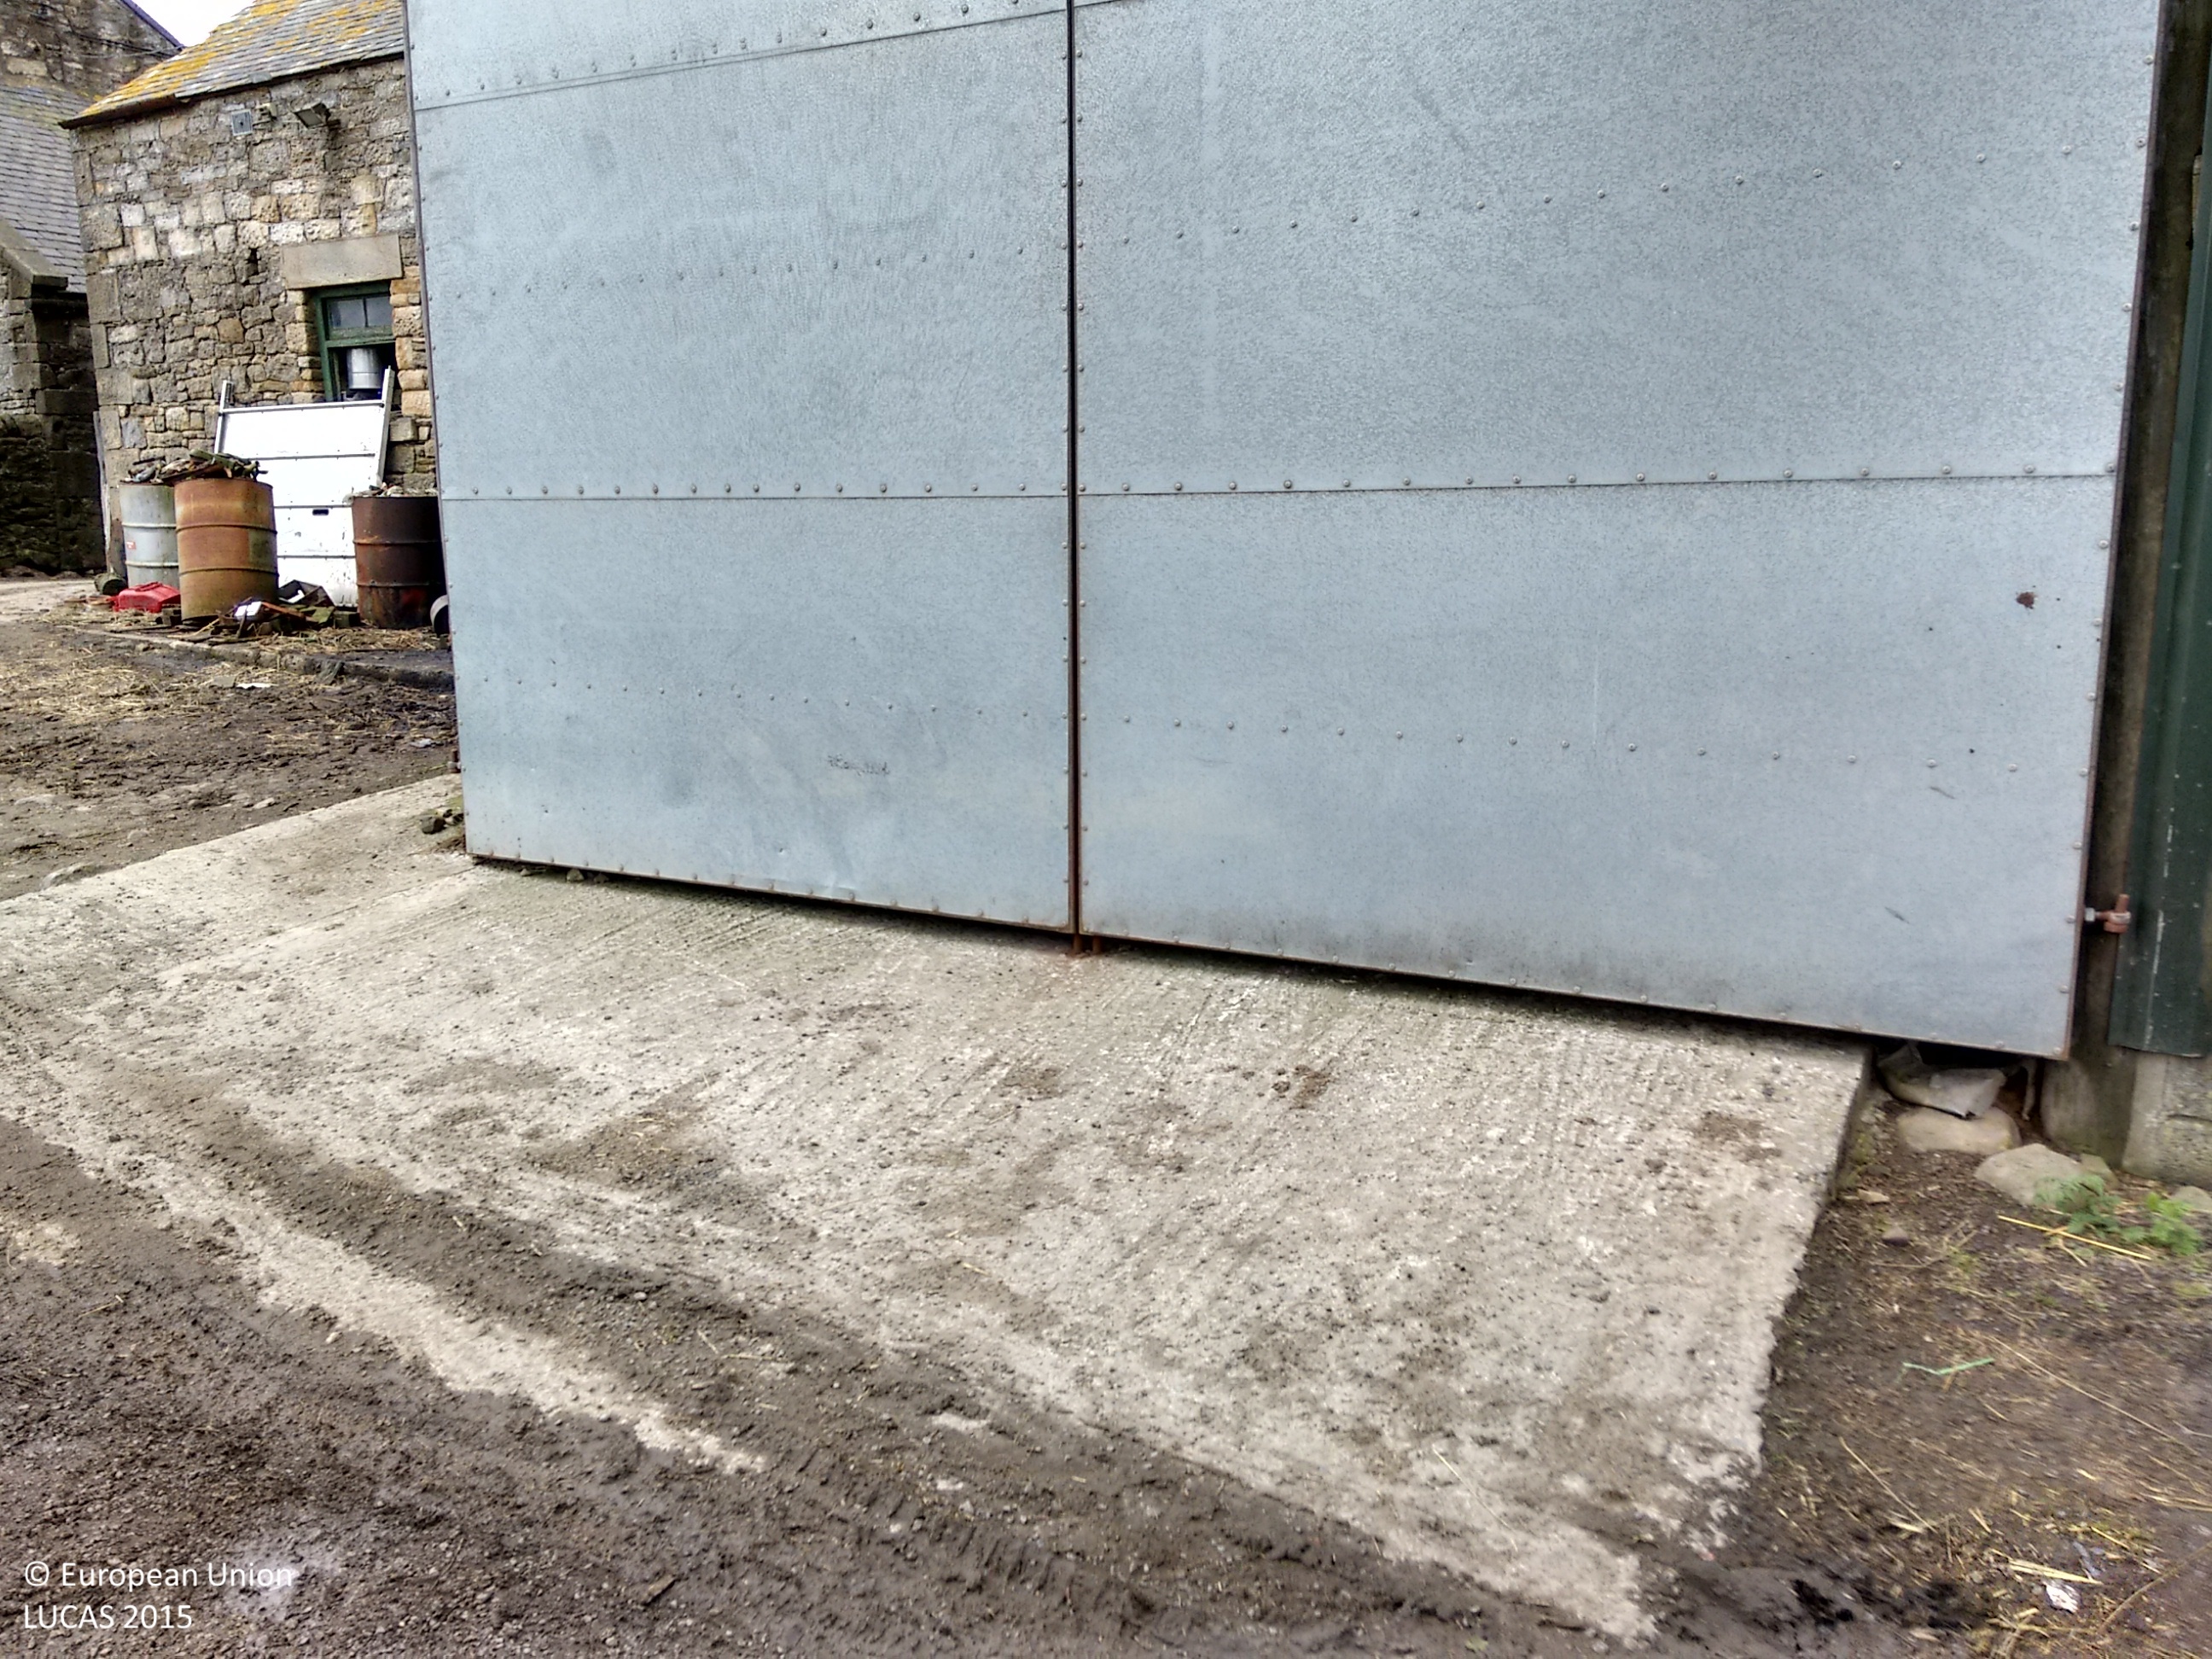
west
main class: Grassland
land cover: Grassland without tree/shrub cover
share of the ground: > 75 %
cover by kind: herbaceous plants 100 %
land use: Agriculture (excluding fallow land and kitchen gardens)
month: May
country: GB
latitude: 54.9517
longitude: -2.1582
